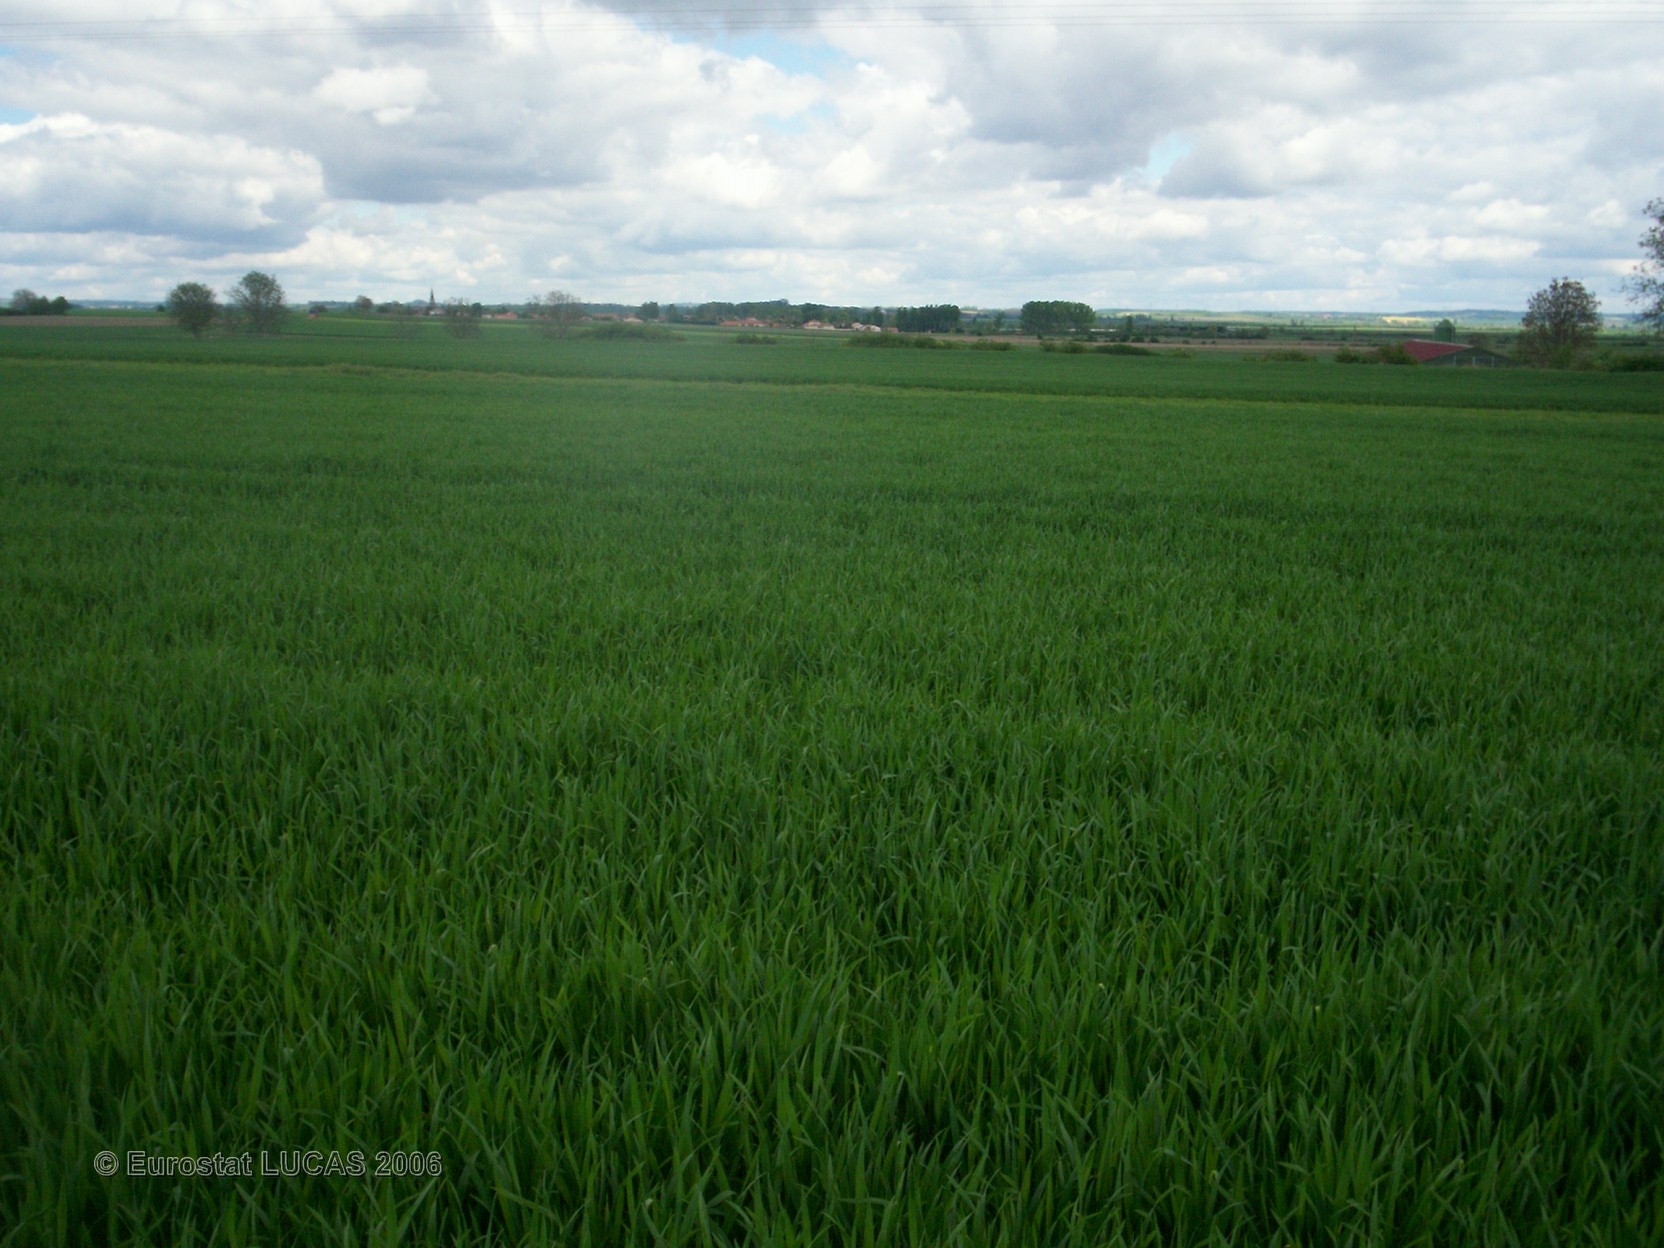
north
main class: Cropland
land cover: Common wheat
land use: Agriculture (excluding fallow land and kitchen gardens)
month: May
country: FR
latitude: 45.9214
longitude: 3.2561
